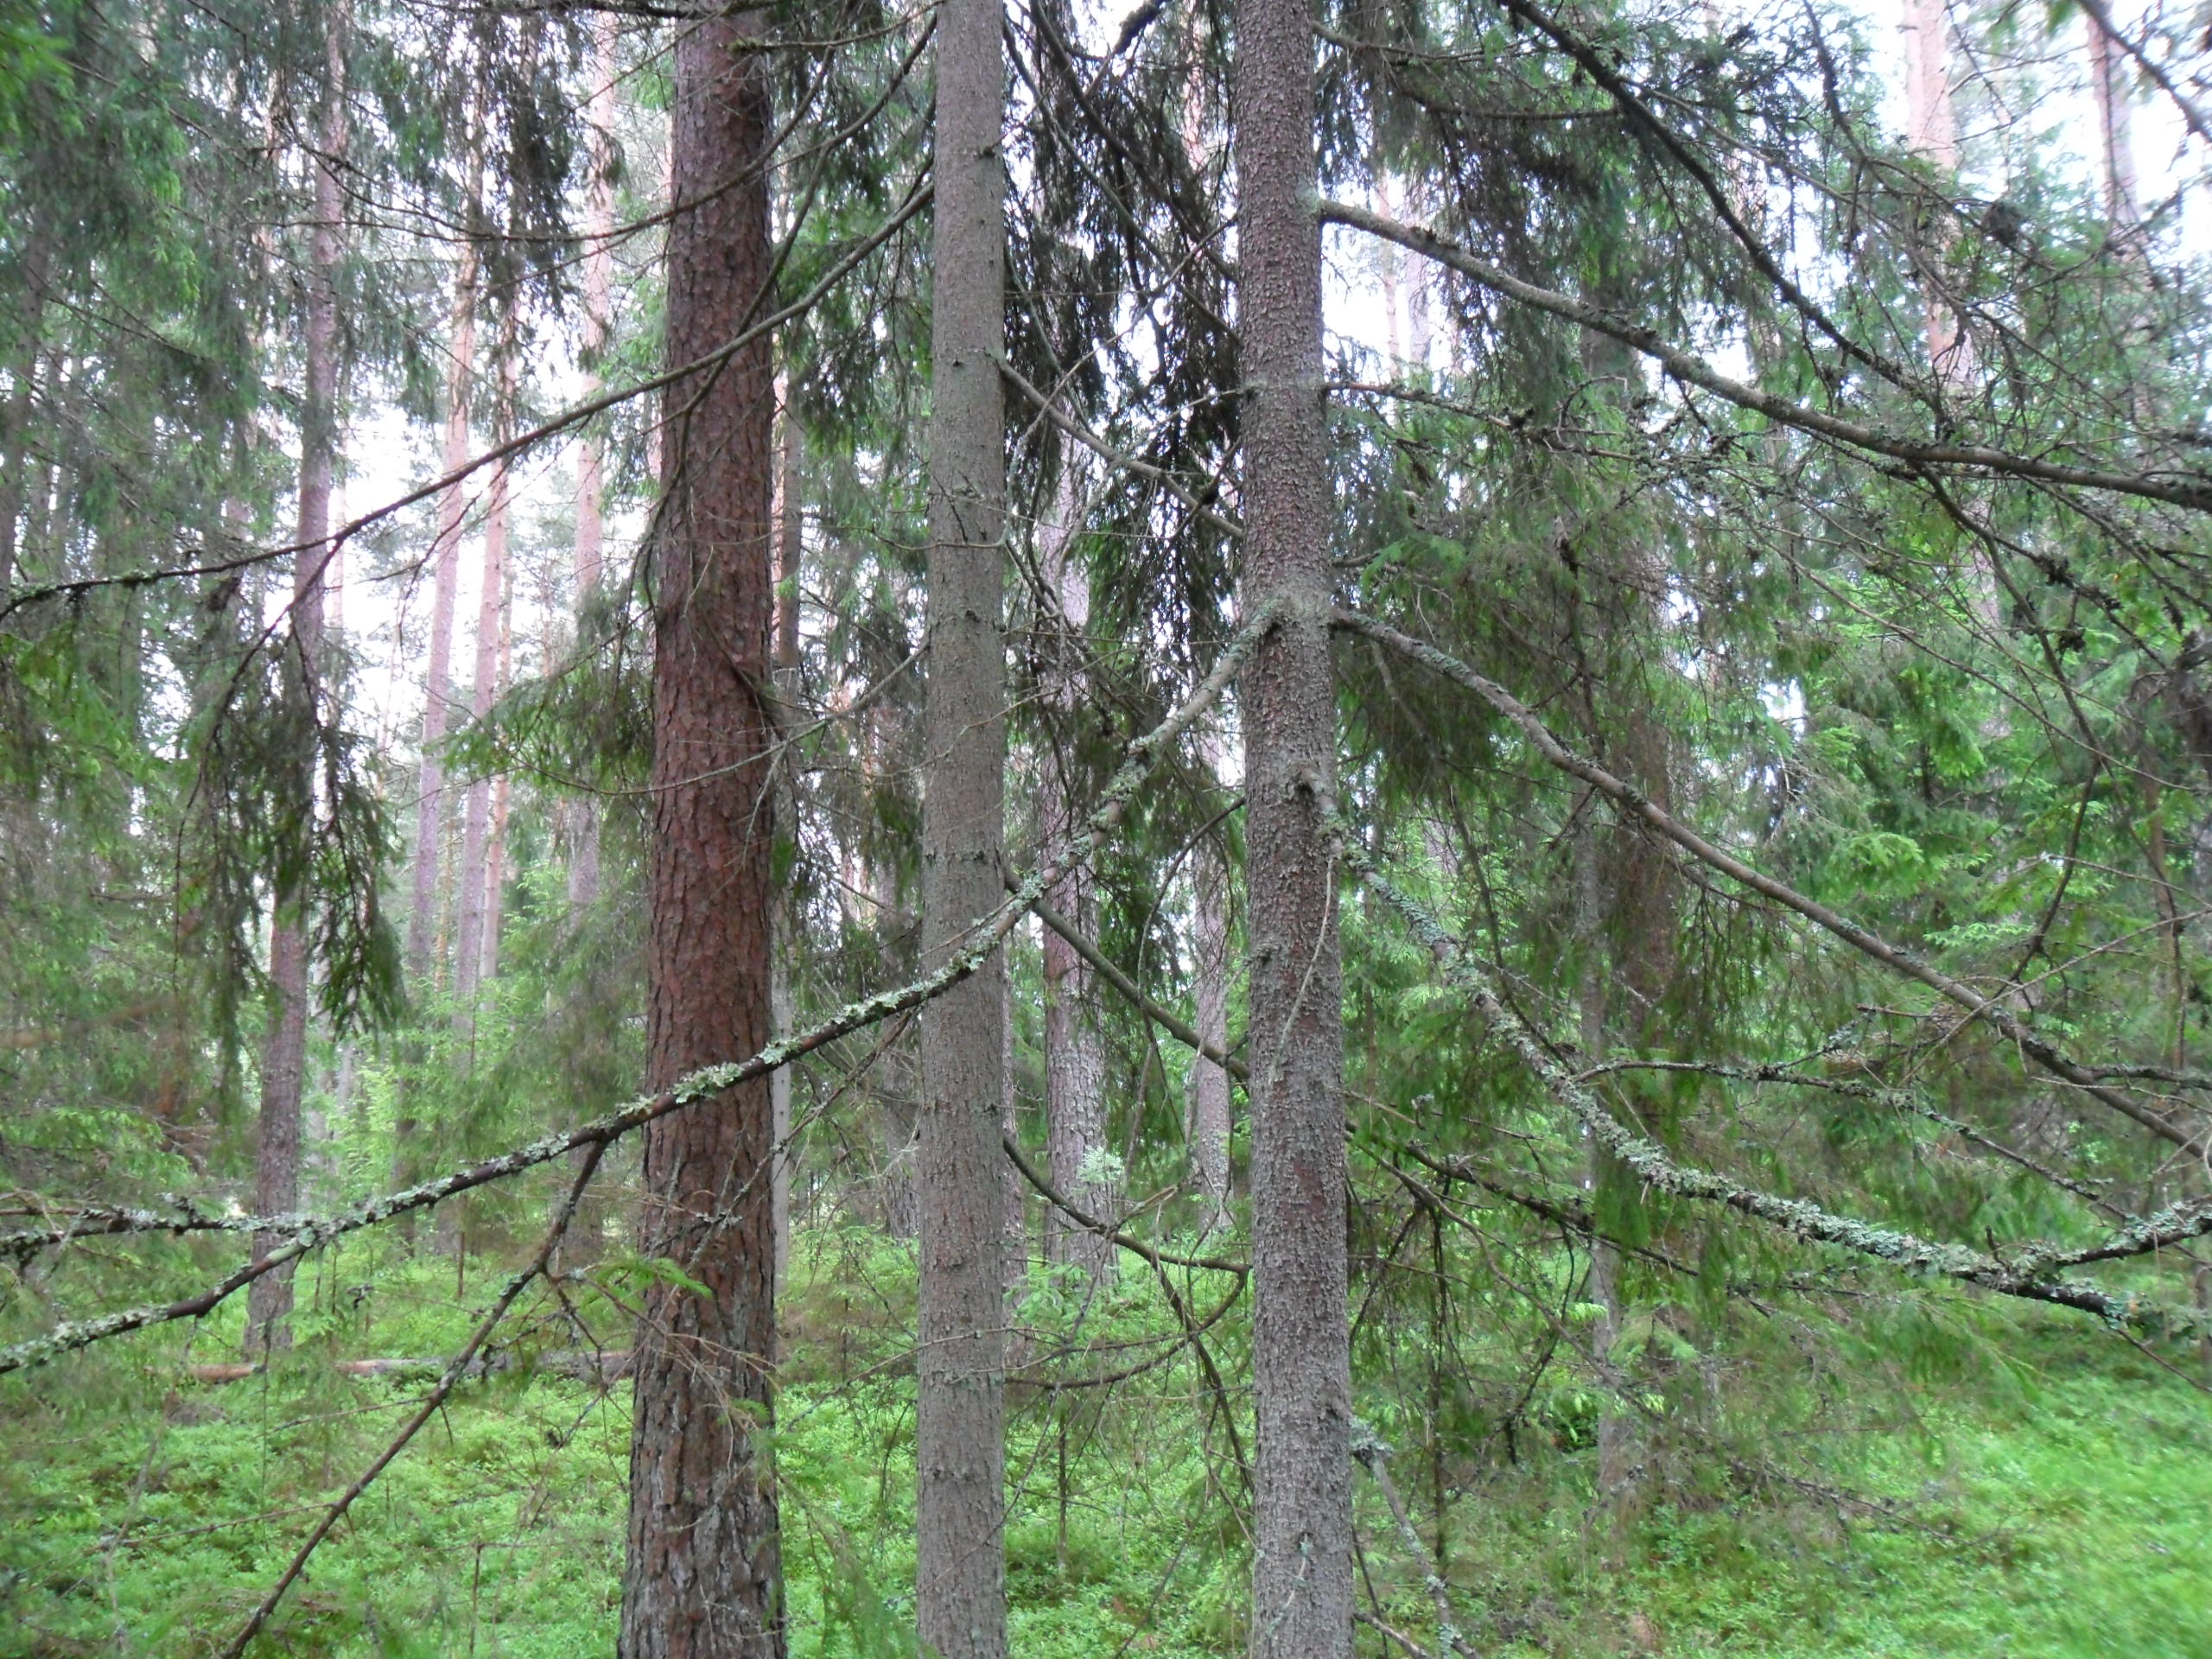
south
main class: Woodland
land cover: Other coniferous woodland
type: hemiboreal forest and nemoral coniferous forest and mixed broadleaved-coniferous forest
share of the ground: > 75 %
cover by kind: coniferous forest trees 75 %, herbaceous plants 25 %
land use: Forestry
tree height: > 5 m
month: June
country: LV
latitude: 57.2486
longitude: 22.1302
